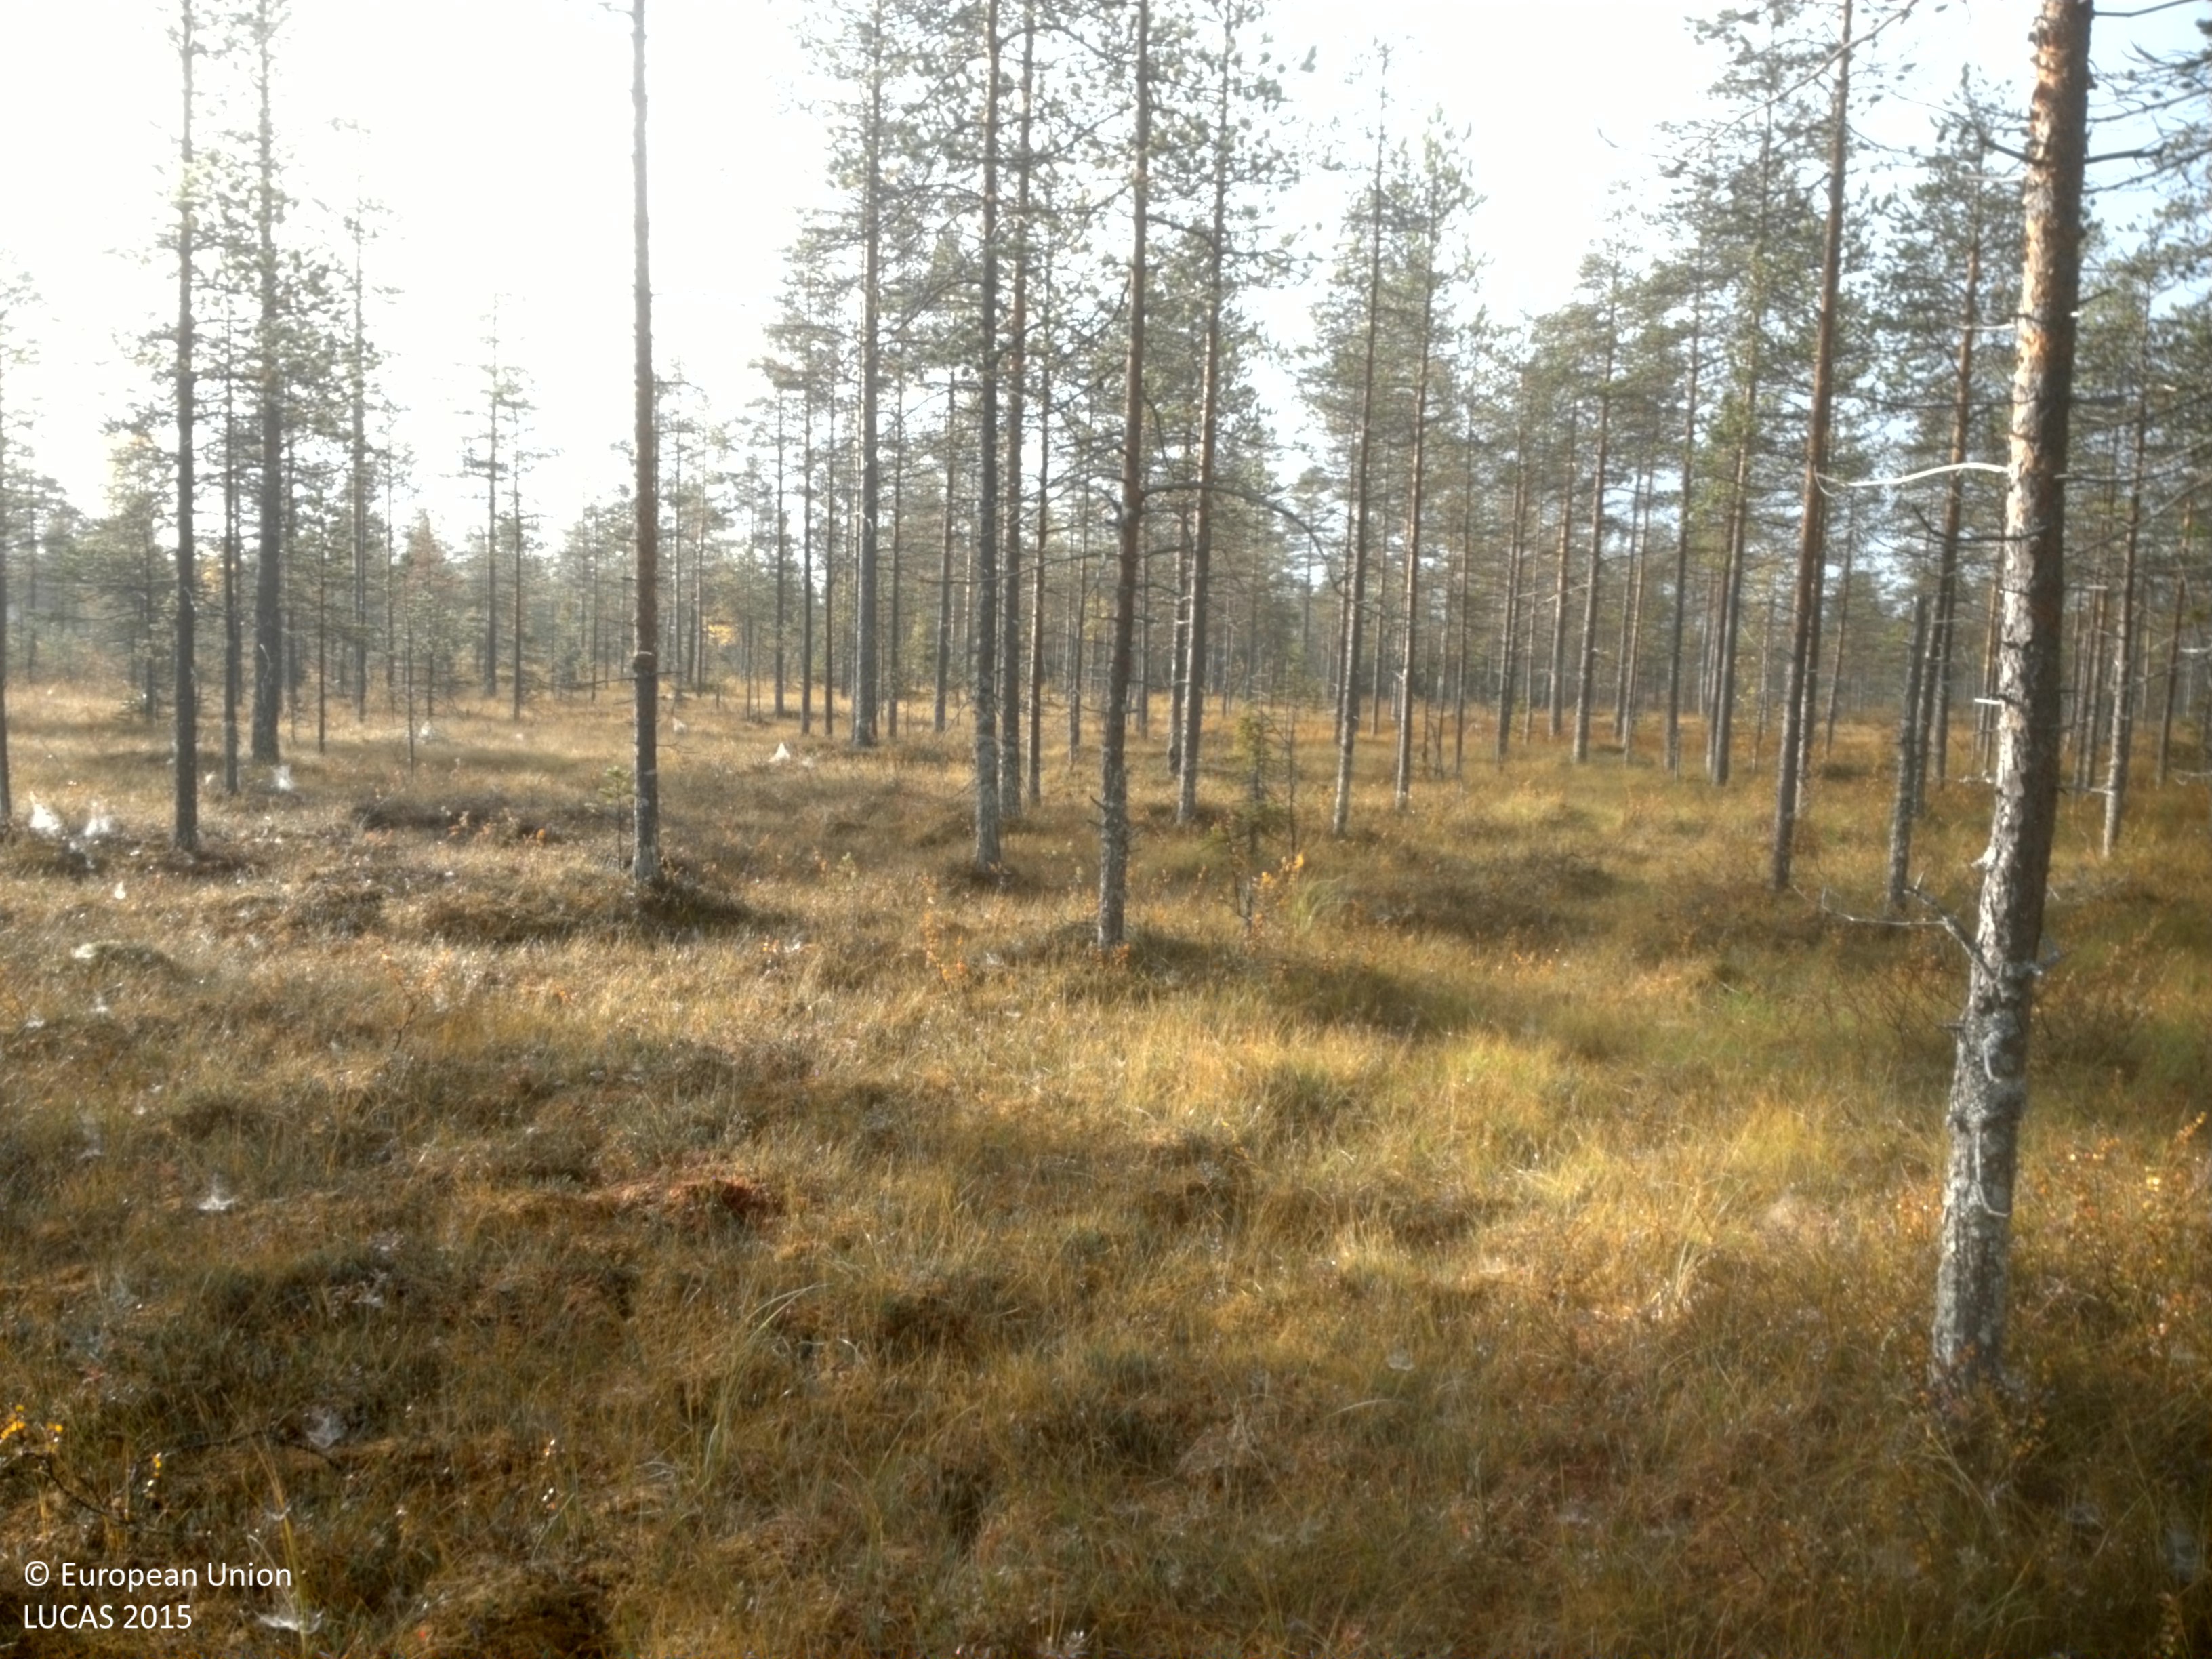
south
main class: Woodland
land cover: Pine dominated coniferous woodland
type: boreal forest
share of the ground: 25 - 50 %
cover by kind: lichens and mosses 40 %, coniferous forest trees 25 %, shrubs 20 %, herbaceous plants 10 %, broadleaved forest trees 5 %
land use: Amenities, museums, leisure
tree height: > 5 m
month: September
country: SE
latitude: 64.3768
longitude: 20.2356
